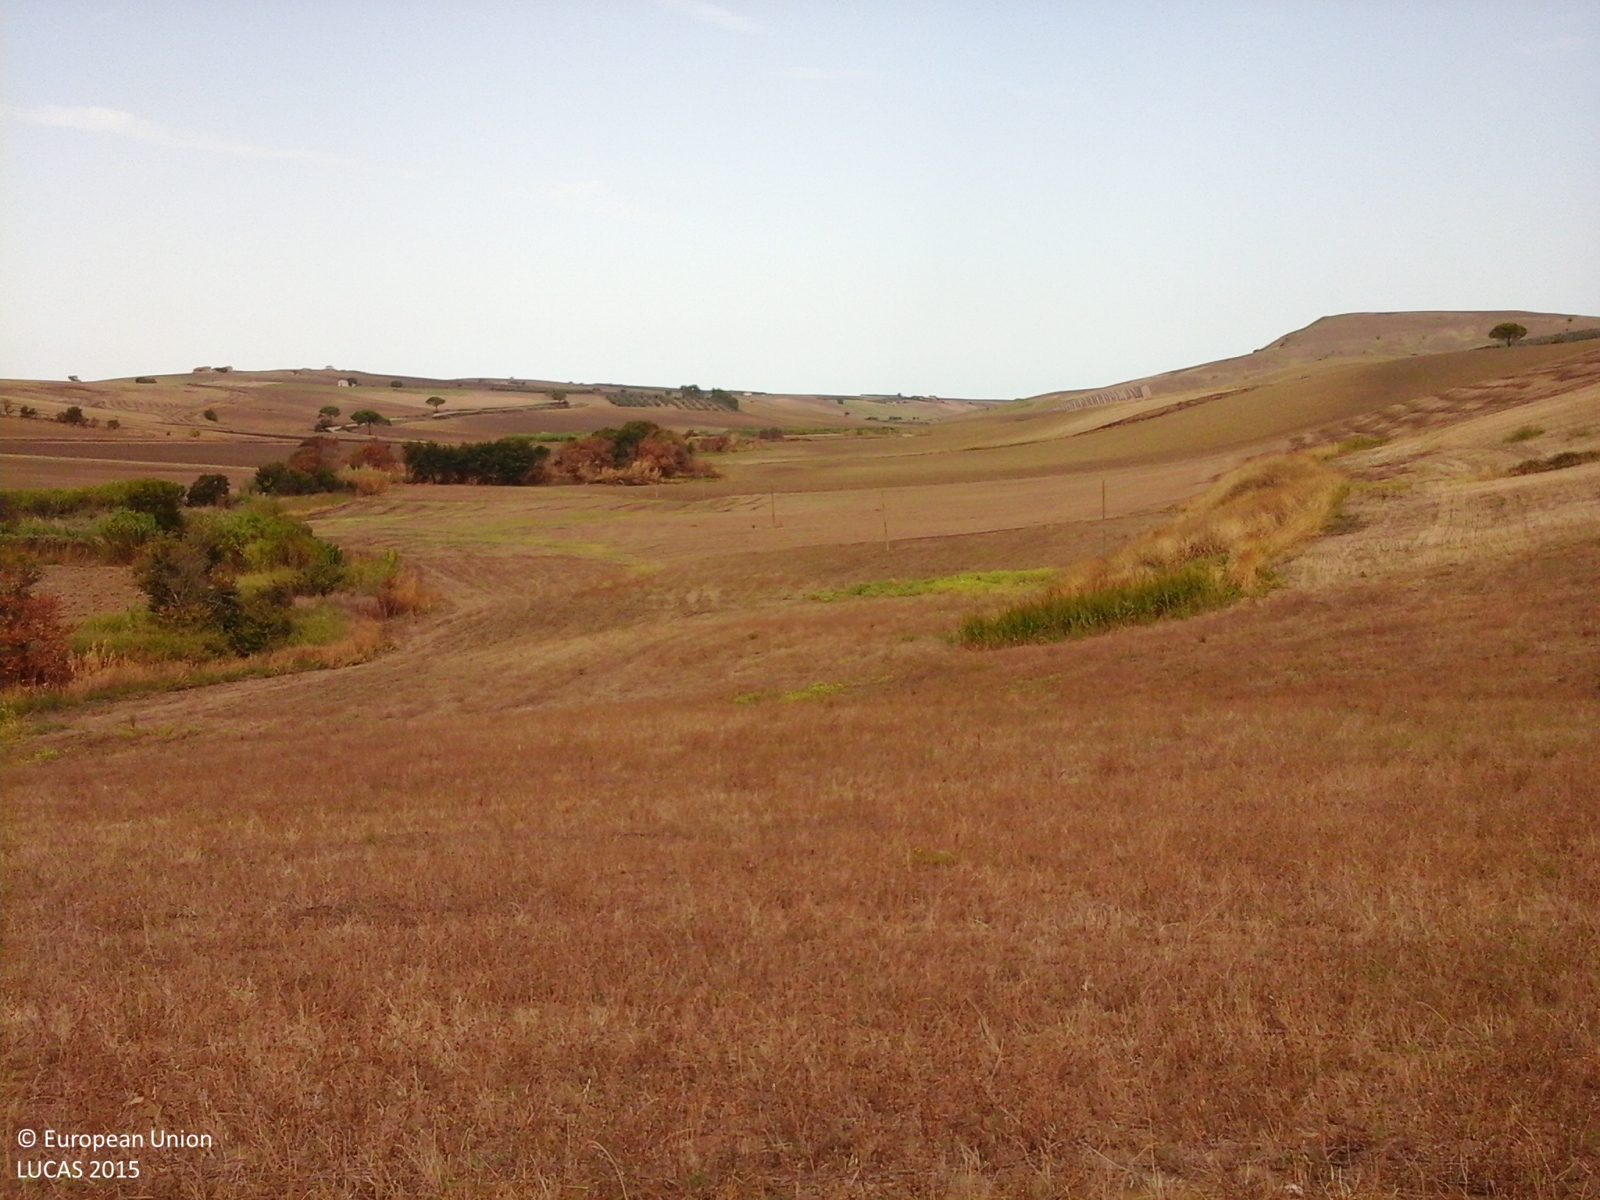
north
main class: Cropland
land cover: Temporary grasslands
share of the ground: > 75 %
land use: Agriculture (excluding fallow land and kitchen gardens)
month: September
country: IT
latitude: 41.8353
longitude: 15.1499
